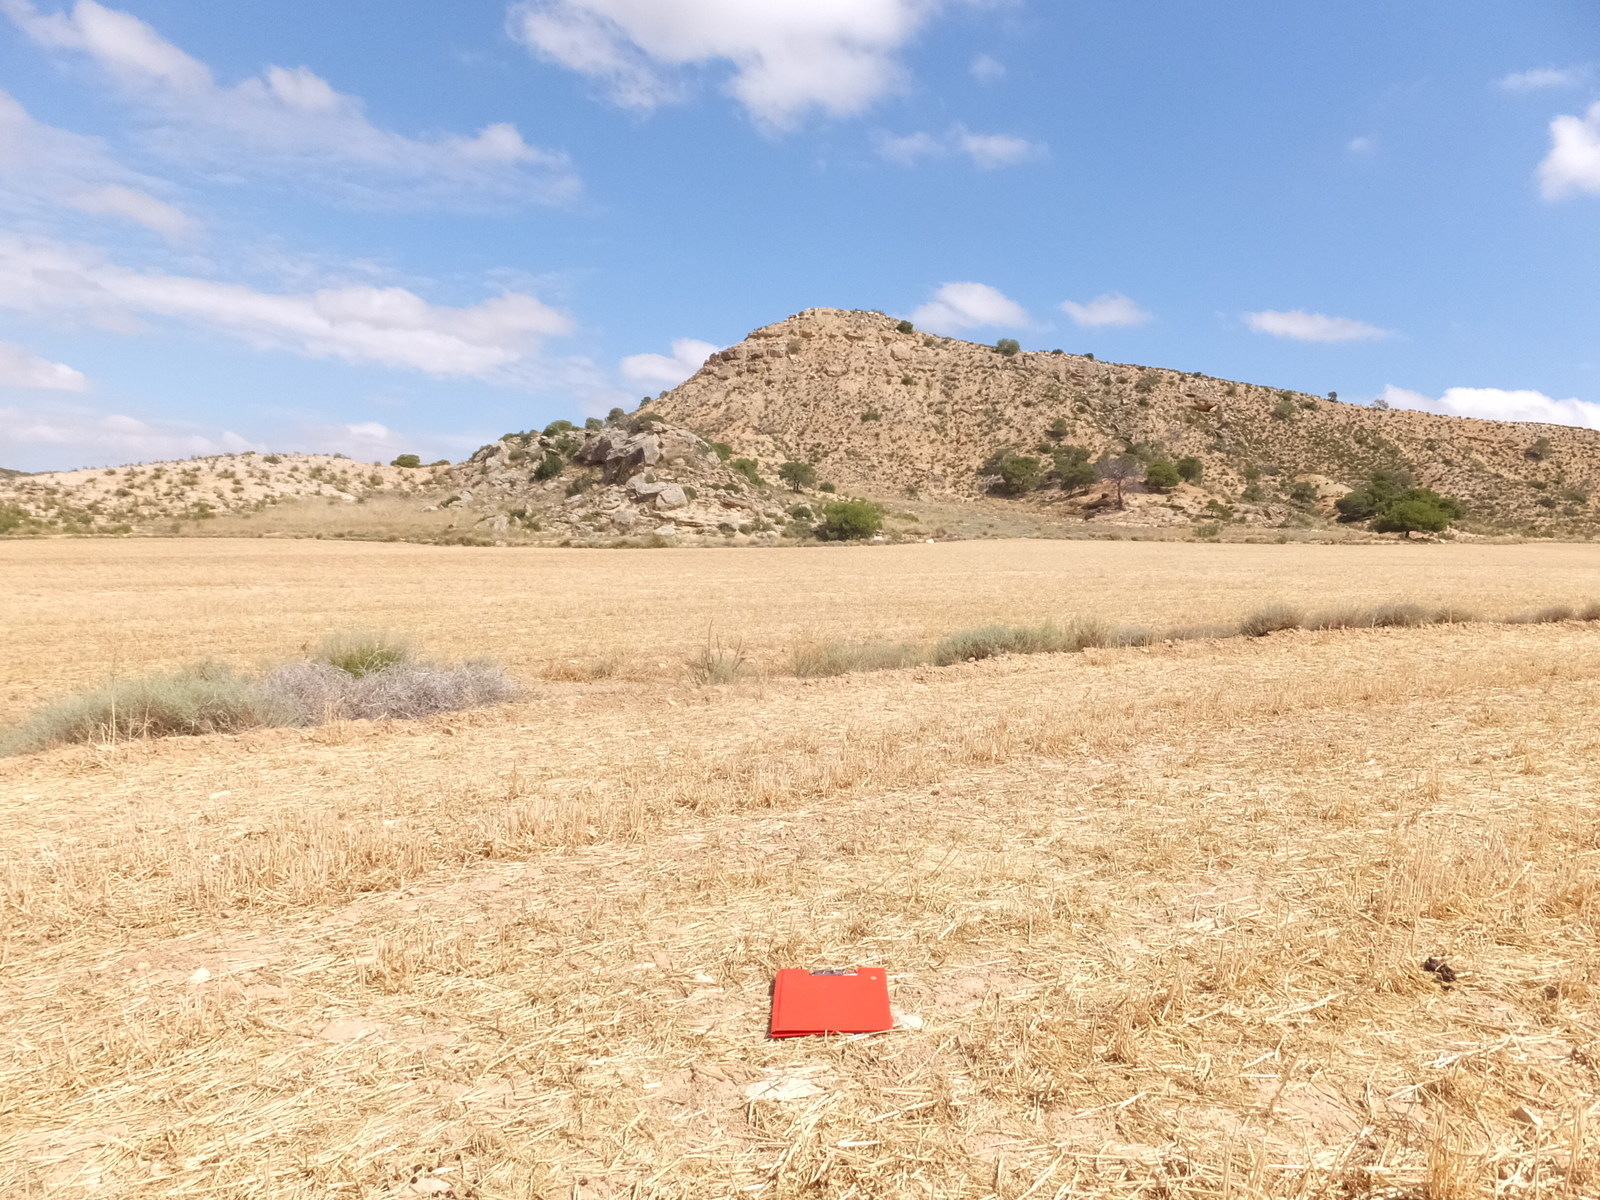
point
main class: Cropland
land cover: Barley
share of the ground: < 10 %
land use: Agriculture (excluding fallow land and kitchen gardens)
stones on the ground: < 10 %
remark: Harvested field
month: June
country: ES
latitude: 41.3306
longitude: -0.0861
